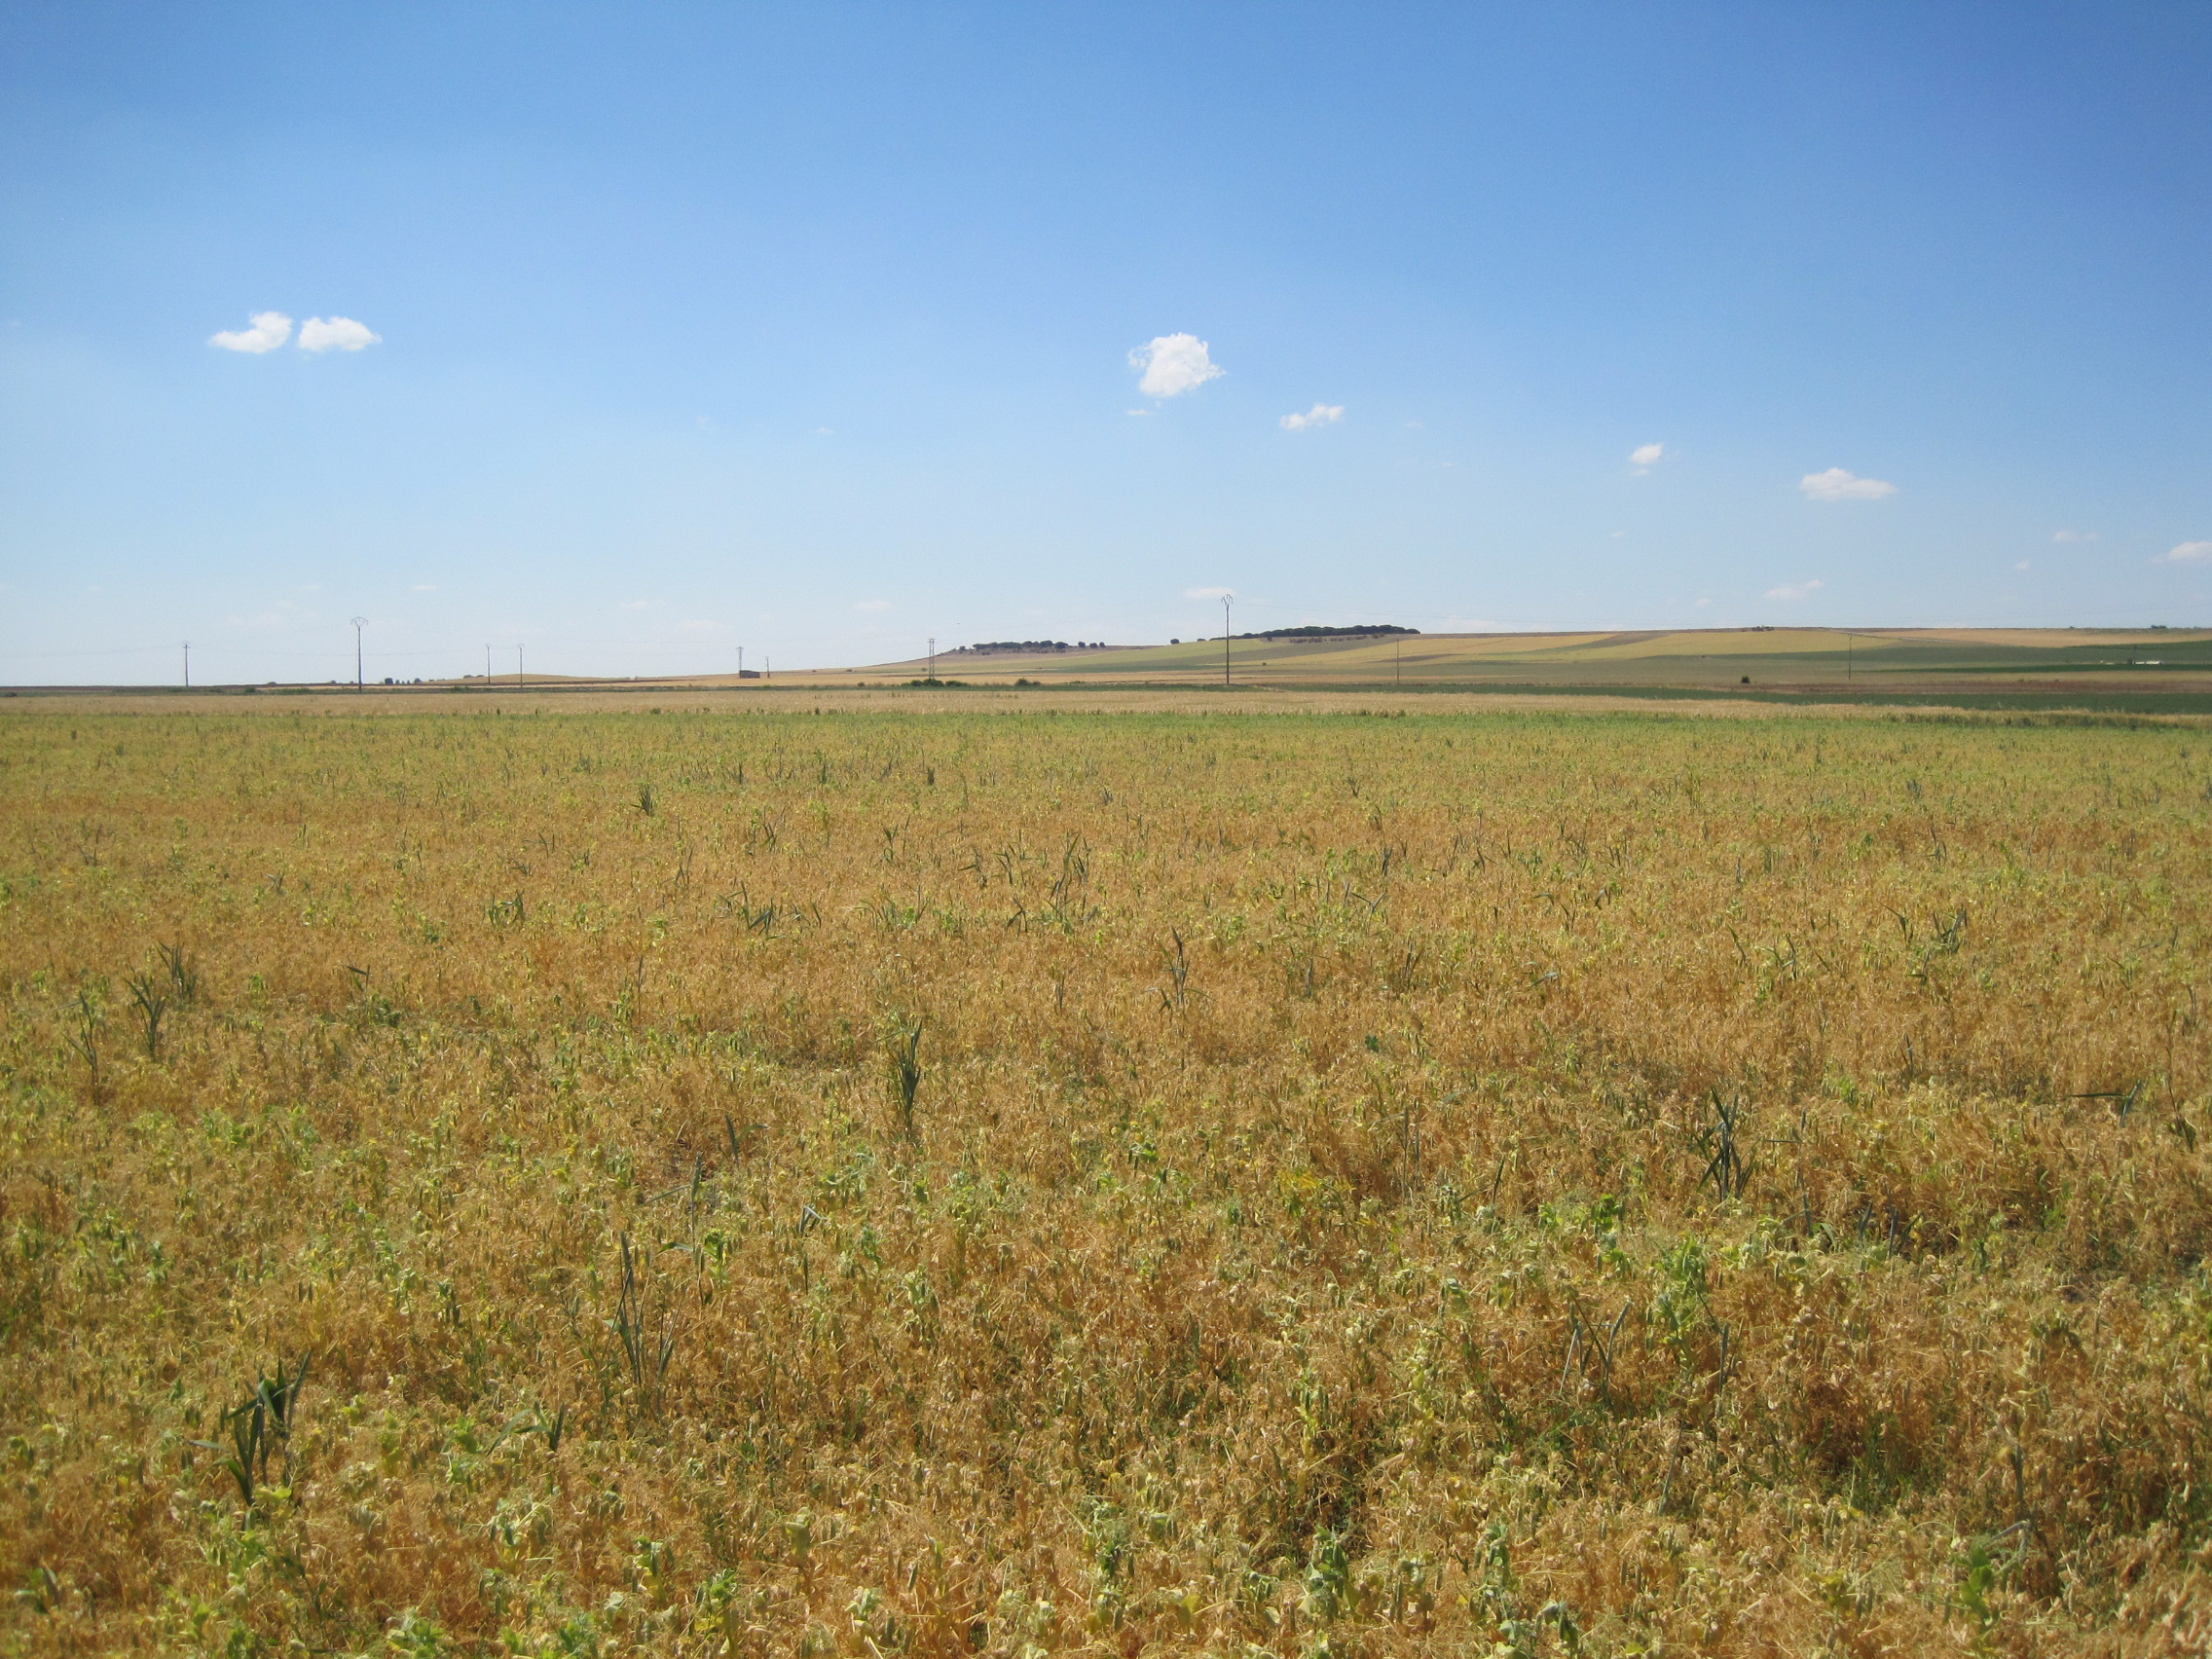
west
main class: Cropland
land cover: Dry pulses
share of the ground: > 75 %
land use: Agriculture (excluding fallow land and kitchen gardens)
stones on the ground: 10 - 25 %
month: May
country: ES
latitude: 41.3147
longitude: -5.0866
